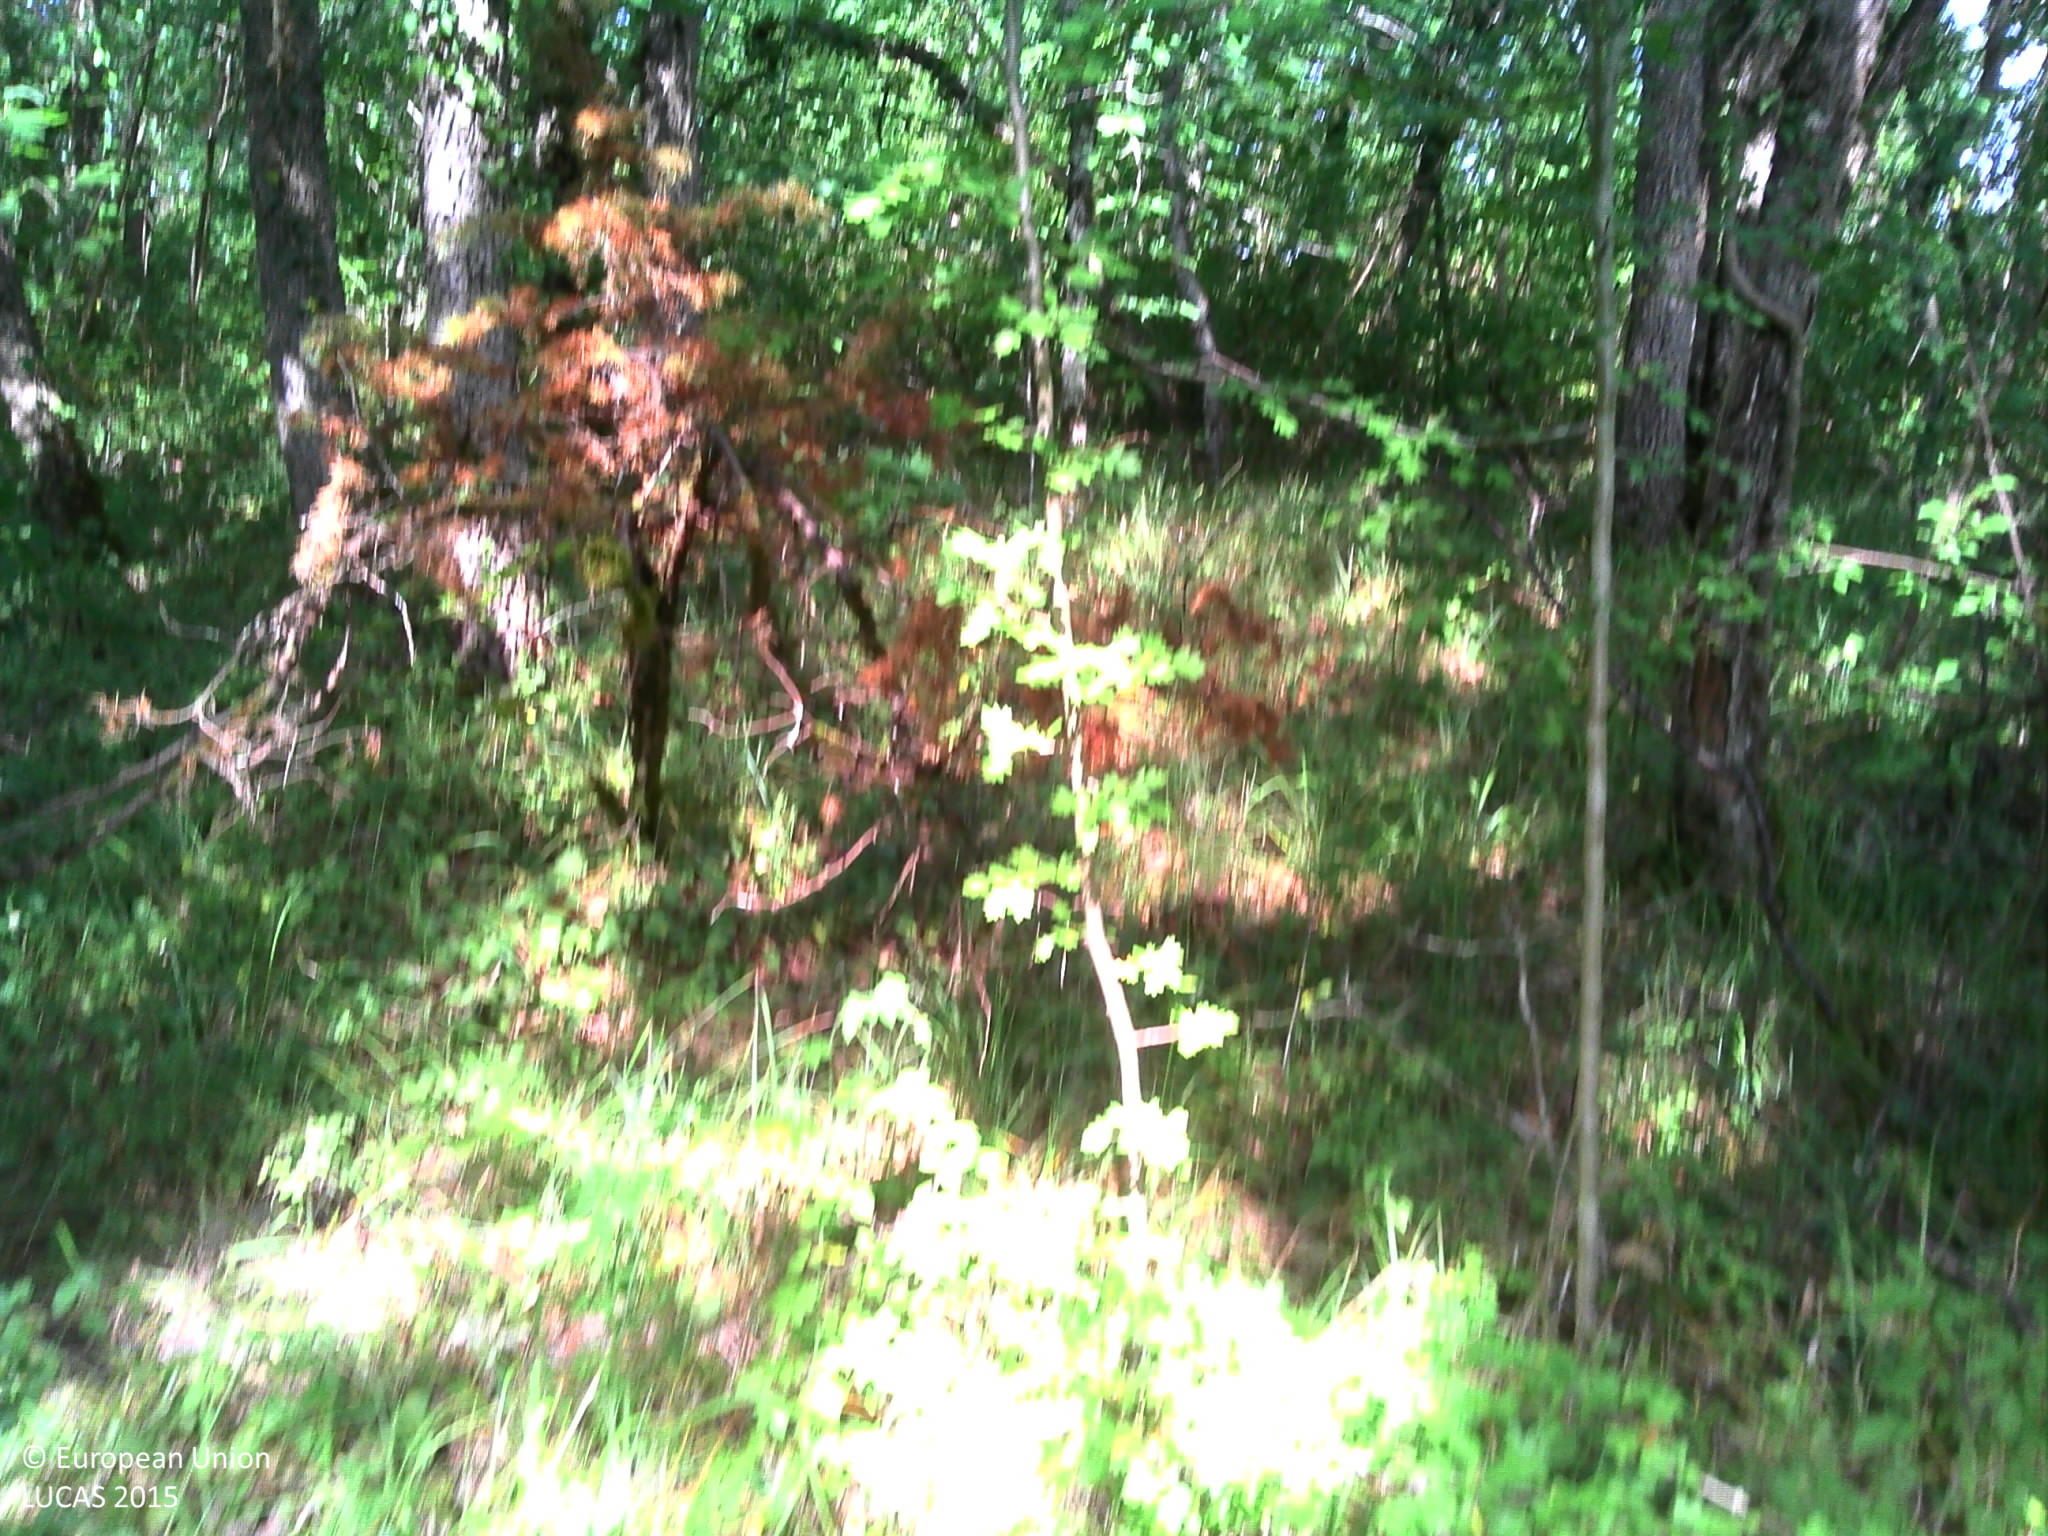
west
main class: Woodland
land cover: Broadleaved woodland
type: thermophilous deciduous forest
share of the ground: > 75 %
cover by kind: broadleaved forest trees 95 %, coniferous forest trees 5 %
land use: Forestry
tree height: > 5 m
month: July
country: FR
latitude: 44.5302
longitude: 0.8968
